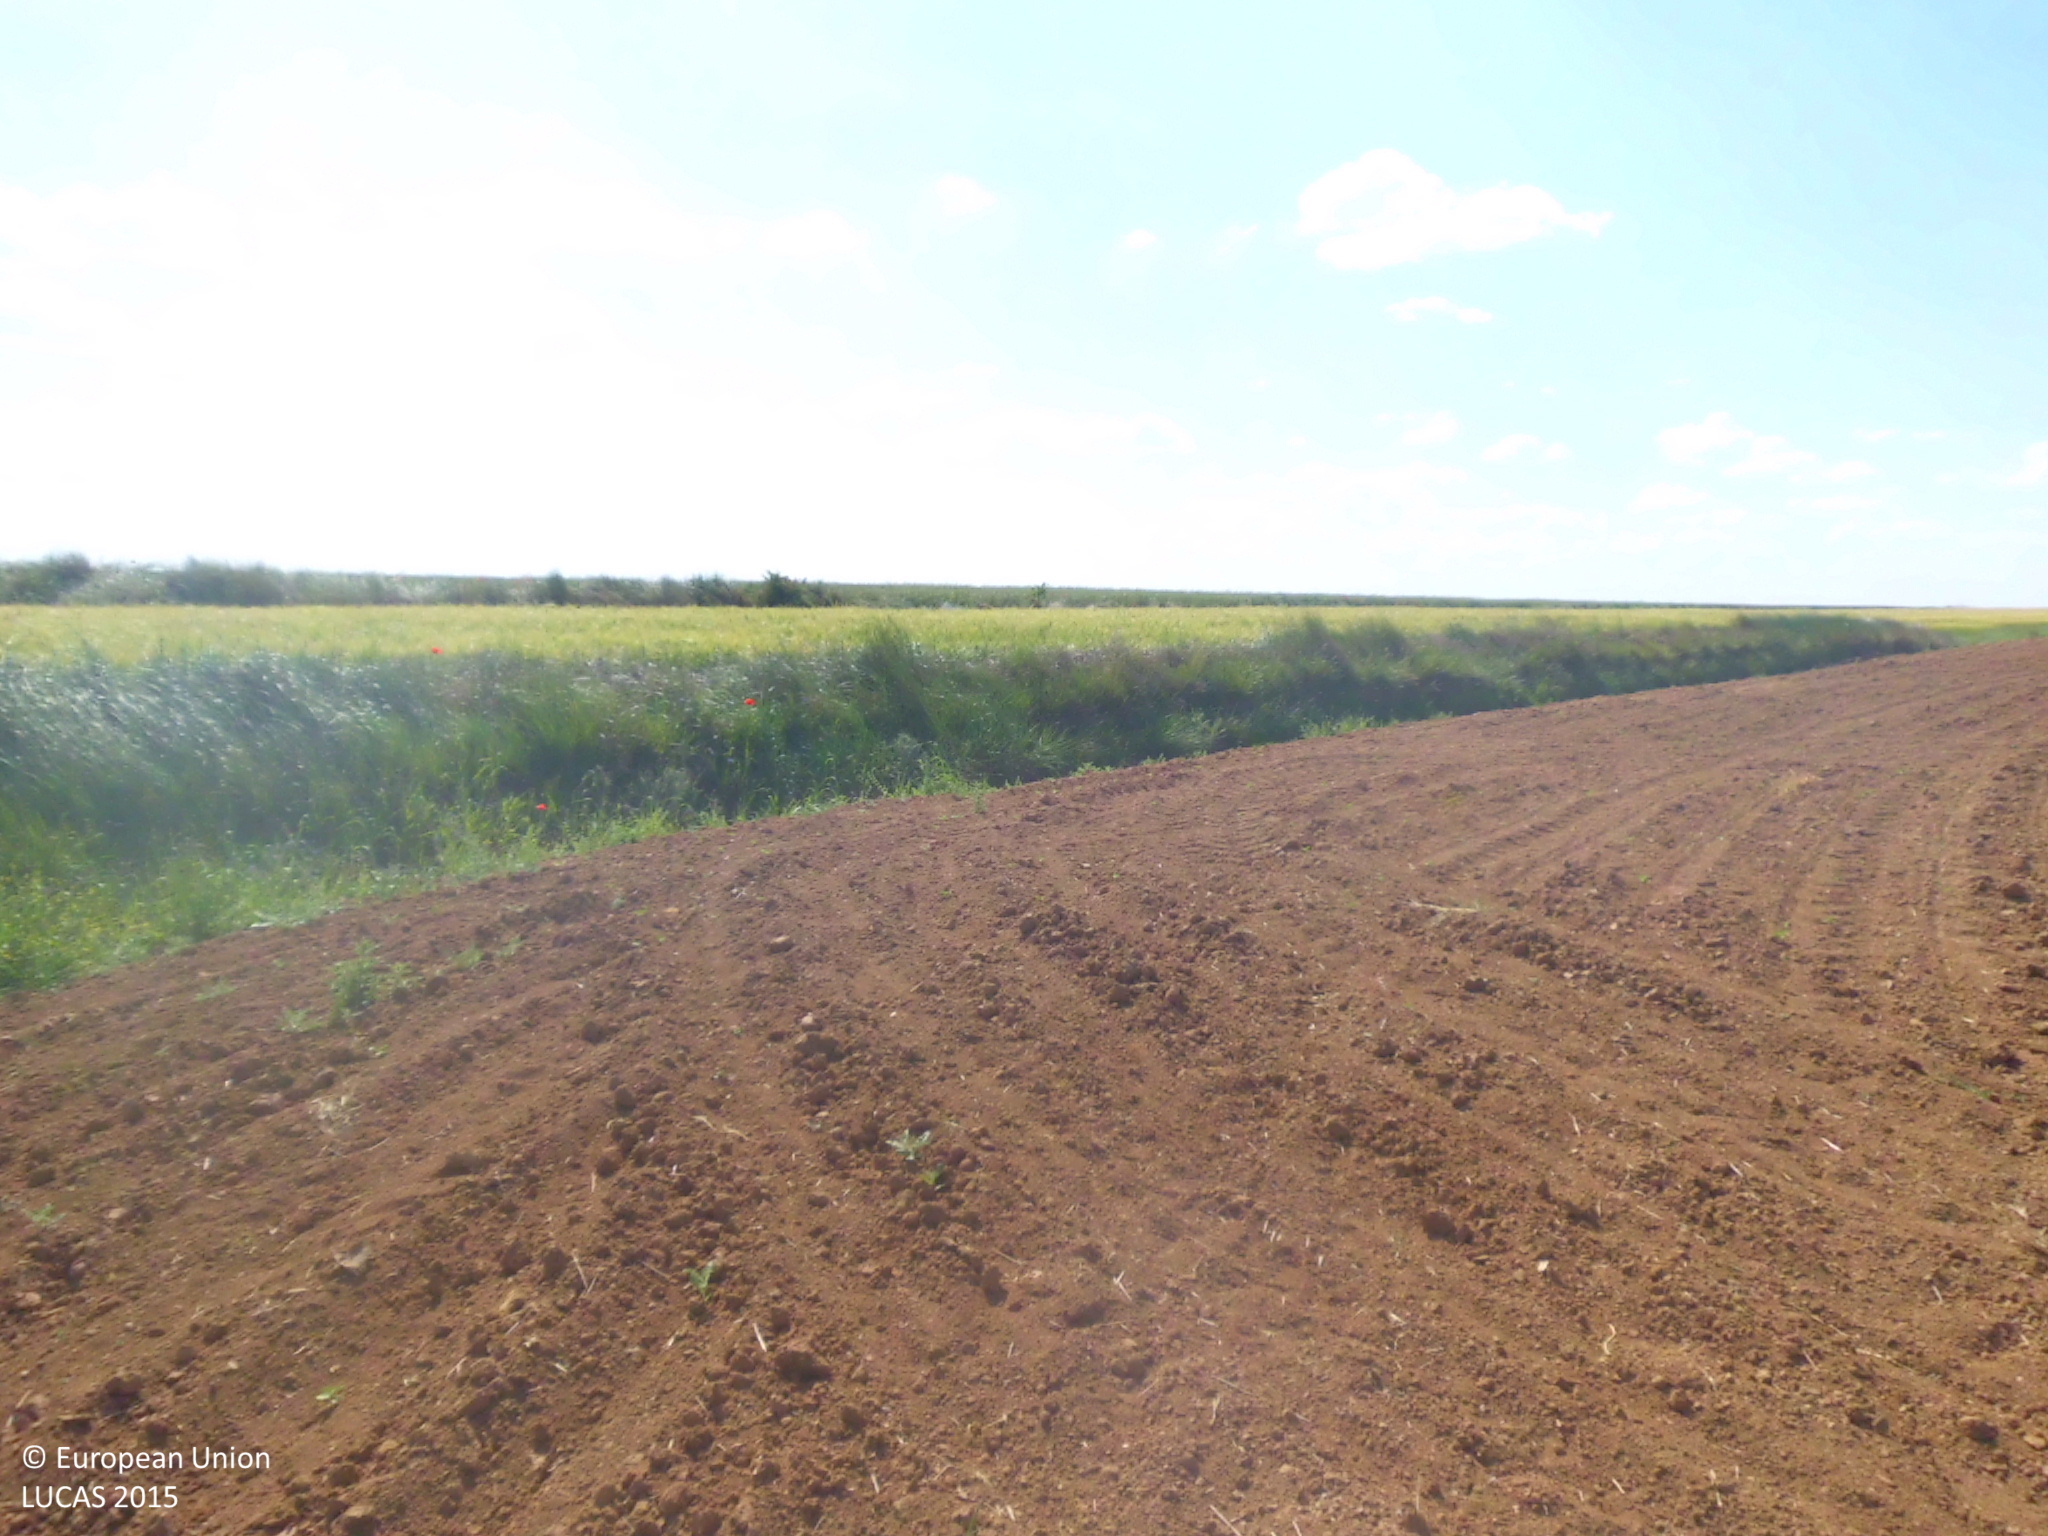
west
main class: Cropland
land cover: Sunflower
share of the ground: < 10 %
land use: Agriculture (excluding fallow land and kitchen gardens)
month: June
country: ES
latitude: 42.4695
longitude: -4.2153
